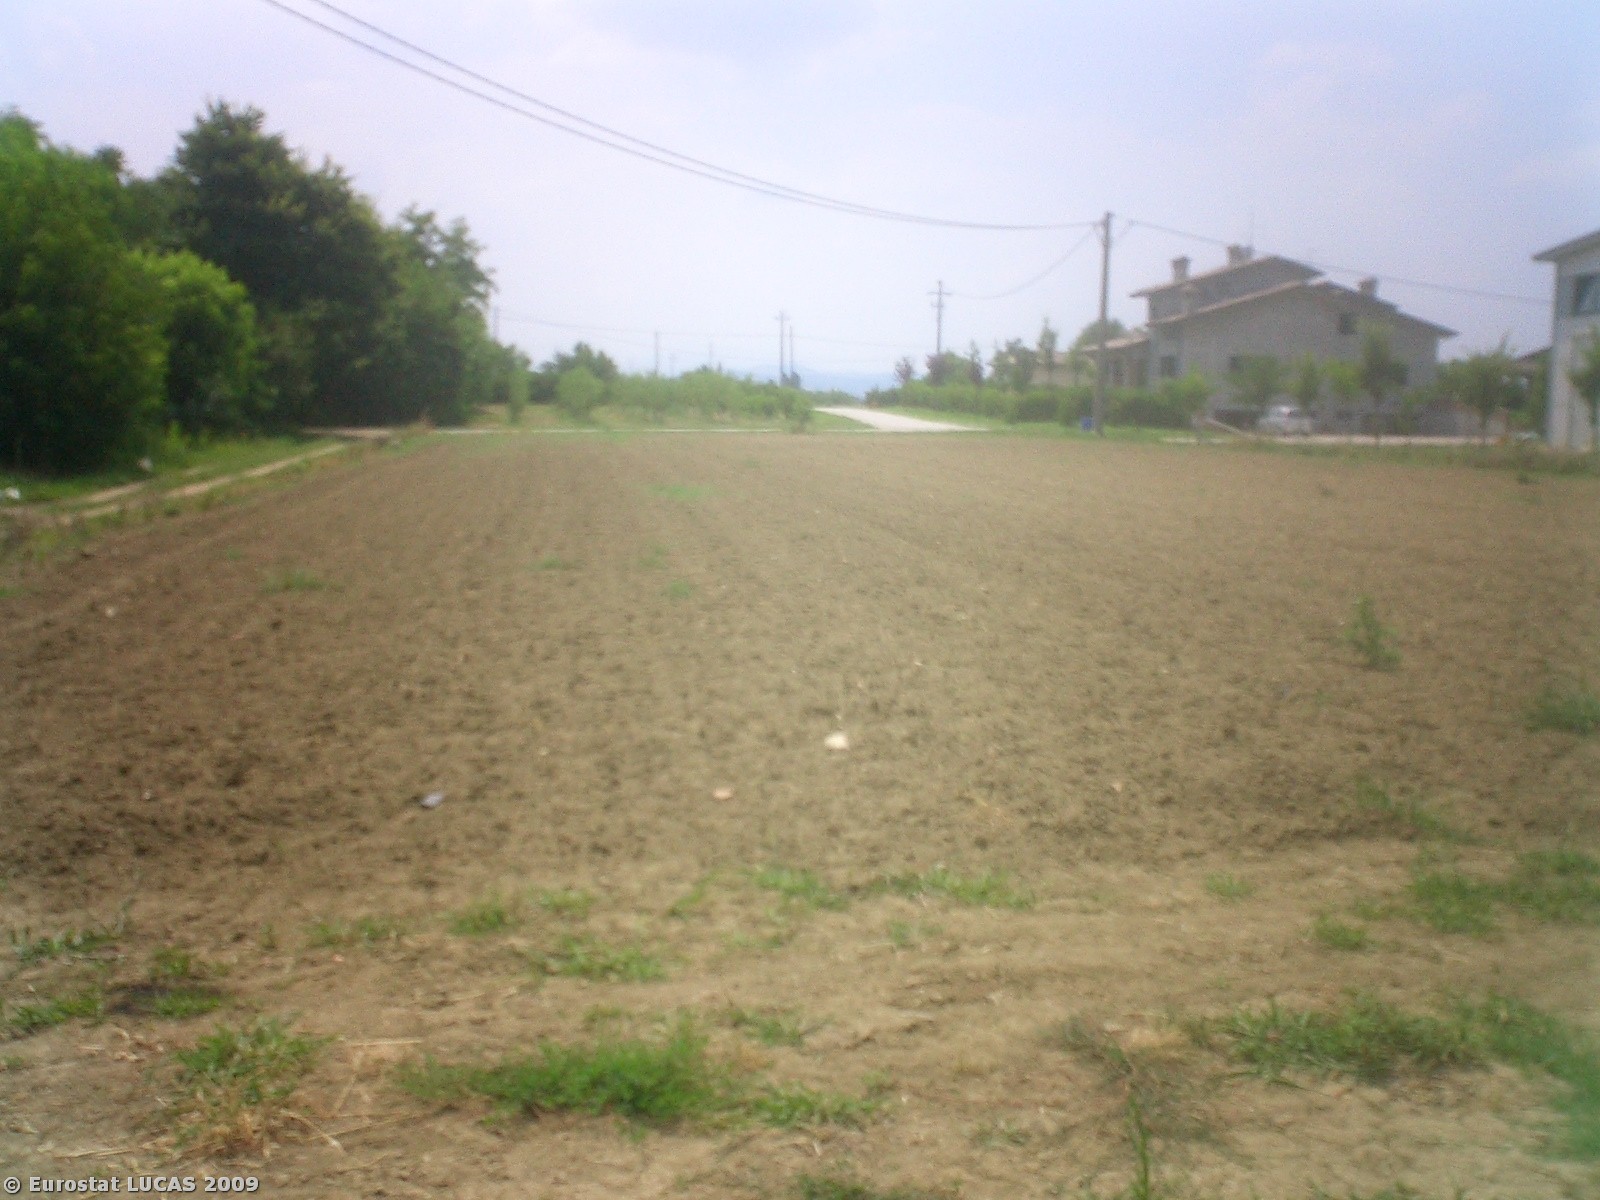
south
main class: Cropland
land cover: Vineyards
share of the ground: 50 - 75 %
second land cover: Grassland with sparse tree/shrub cover
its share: 50 - 75 %
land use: Agriculture (excluding fallow land and kitchen gardens)
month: July
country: IT
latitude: 44.1428
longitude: 12.3823
